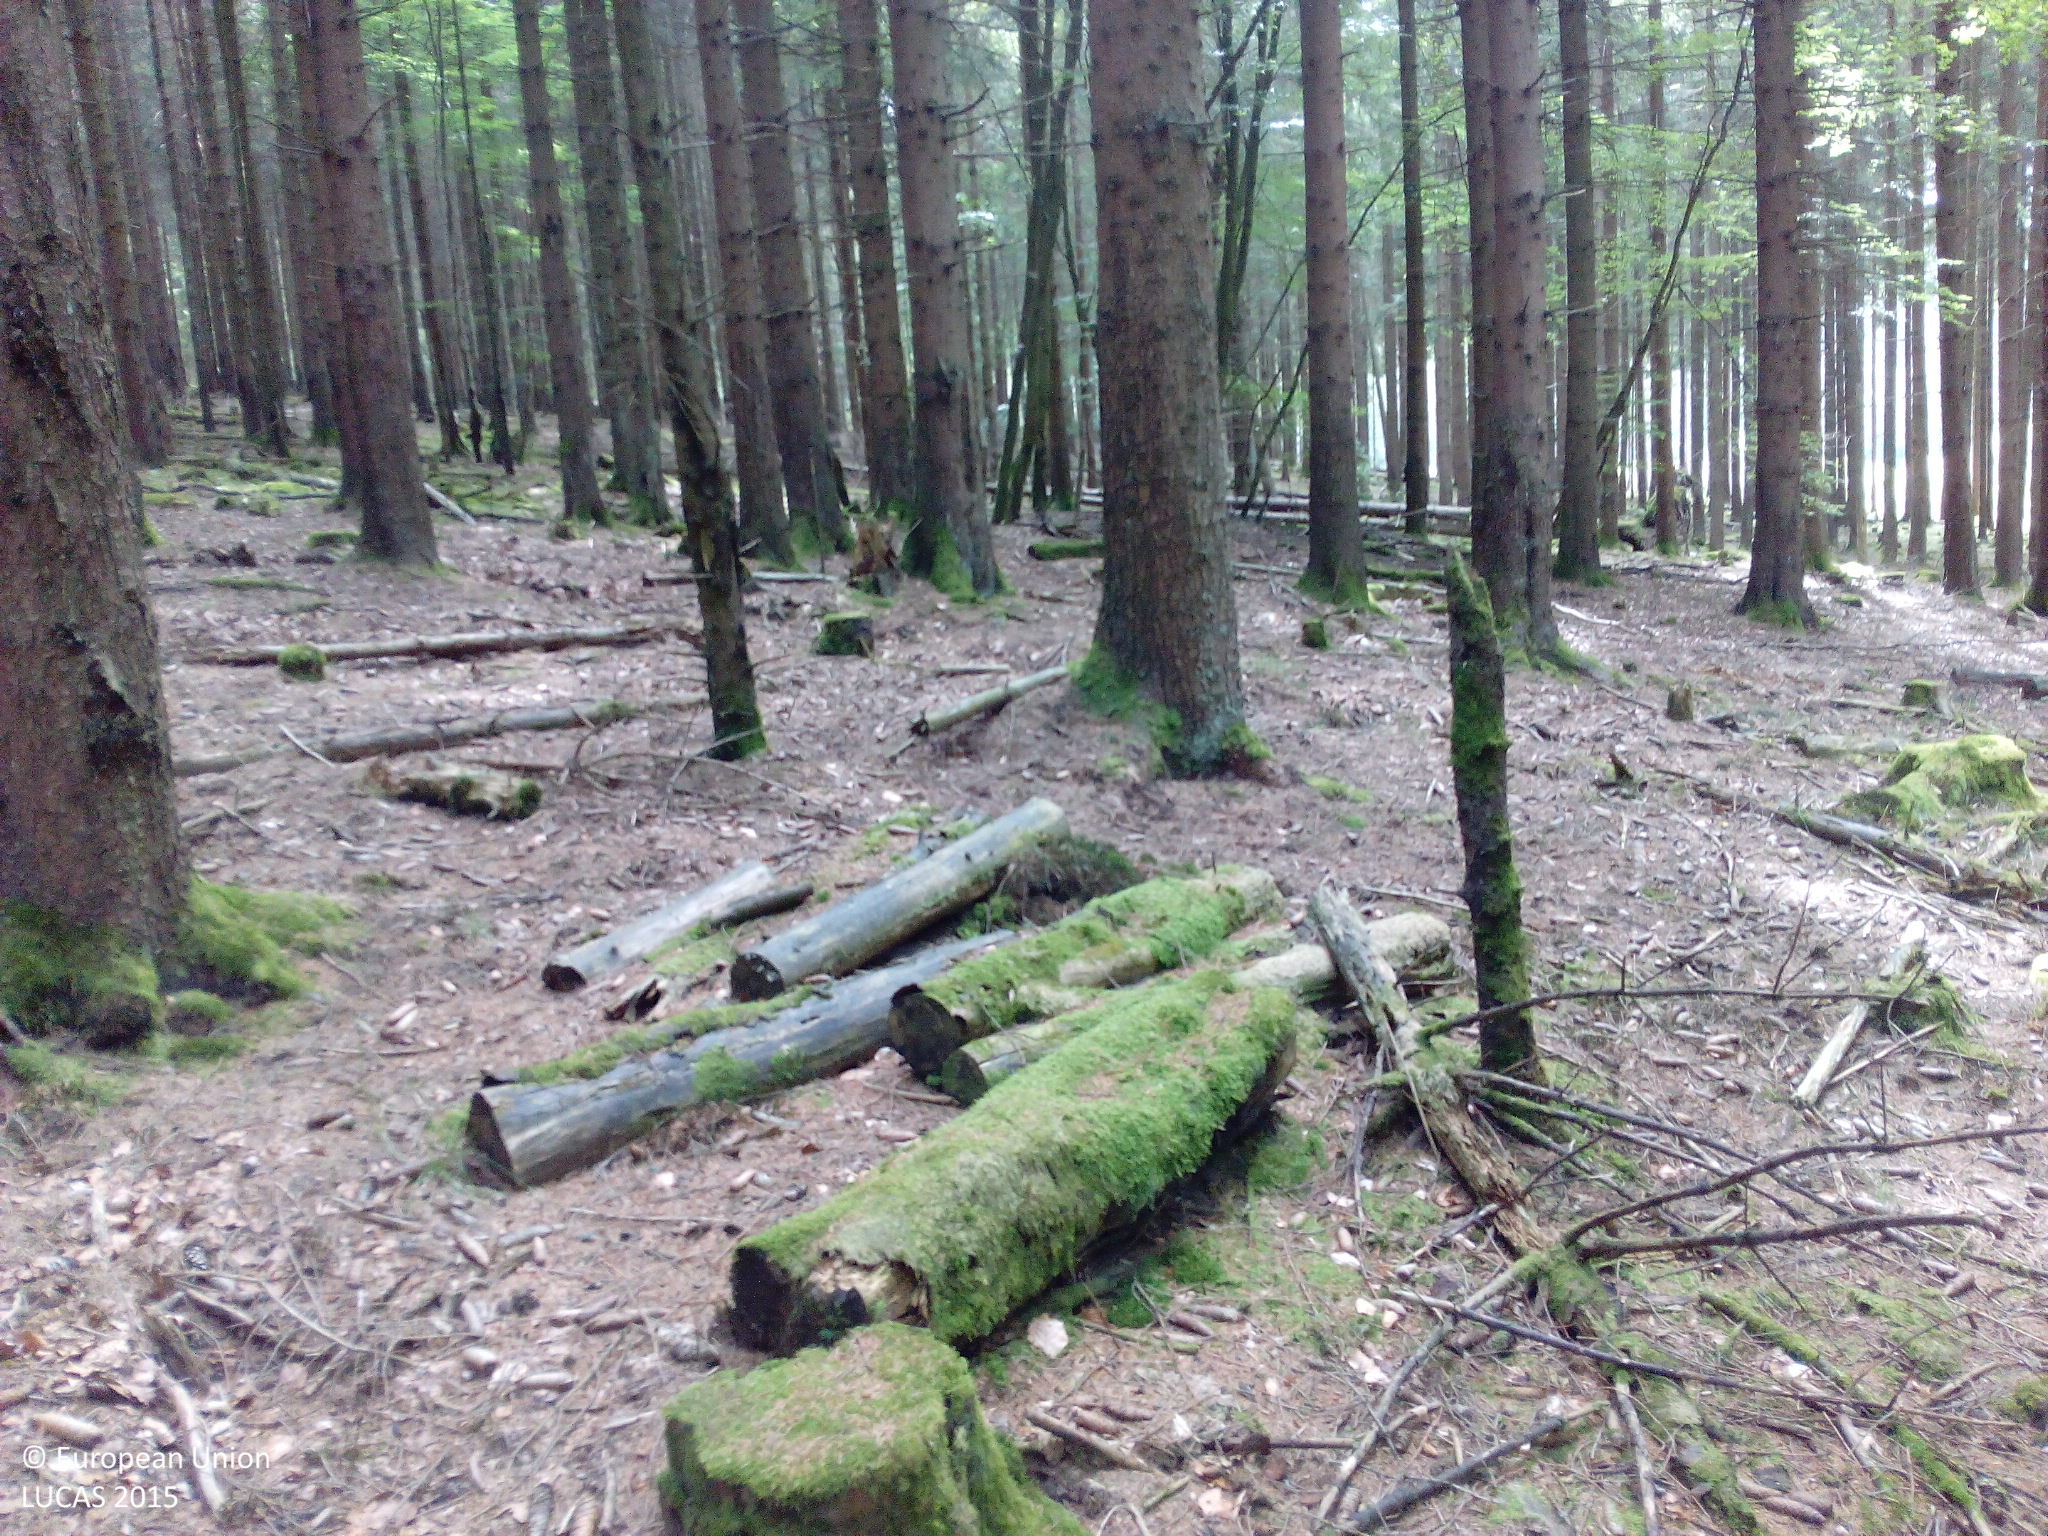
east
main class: Woodland
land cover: Spruce dominated coniferous woodland
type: hemiboreal forest and nemoral coniferous forest and mixed broadleaved-coniferous forest
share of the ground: > 75 %
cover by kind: coniferous forest trees 95 %, broadleaved forest trees 5 %
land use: Forestry
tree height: > 5 m
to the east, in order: Spruce dominated coniferous woodland; Broadleaved woodland; Ditches and canals; Grass margins; Paved roads, cycling and walking lanes; Grass margins; Spruce dominated coniferous woodland
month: July
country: DE
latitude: 49.7895
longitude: 7.1805
